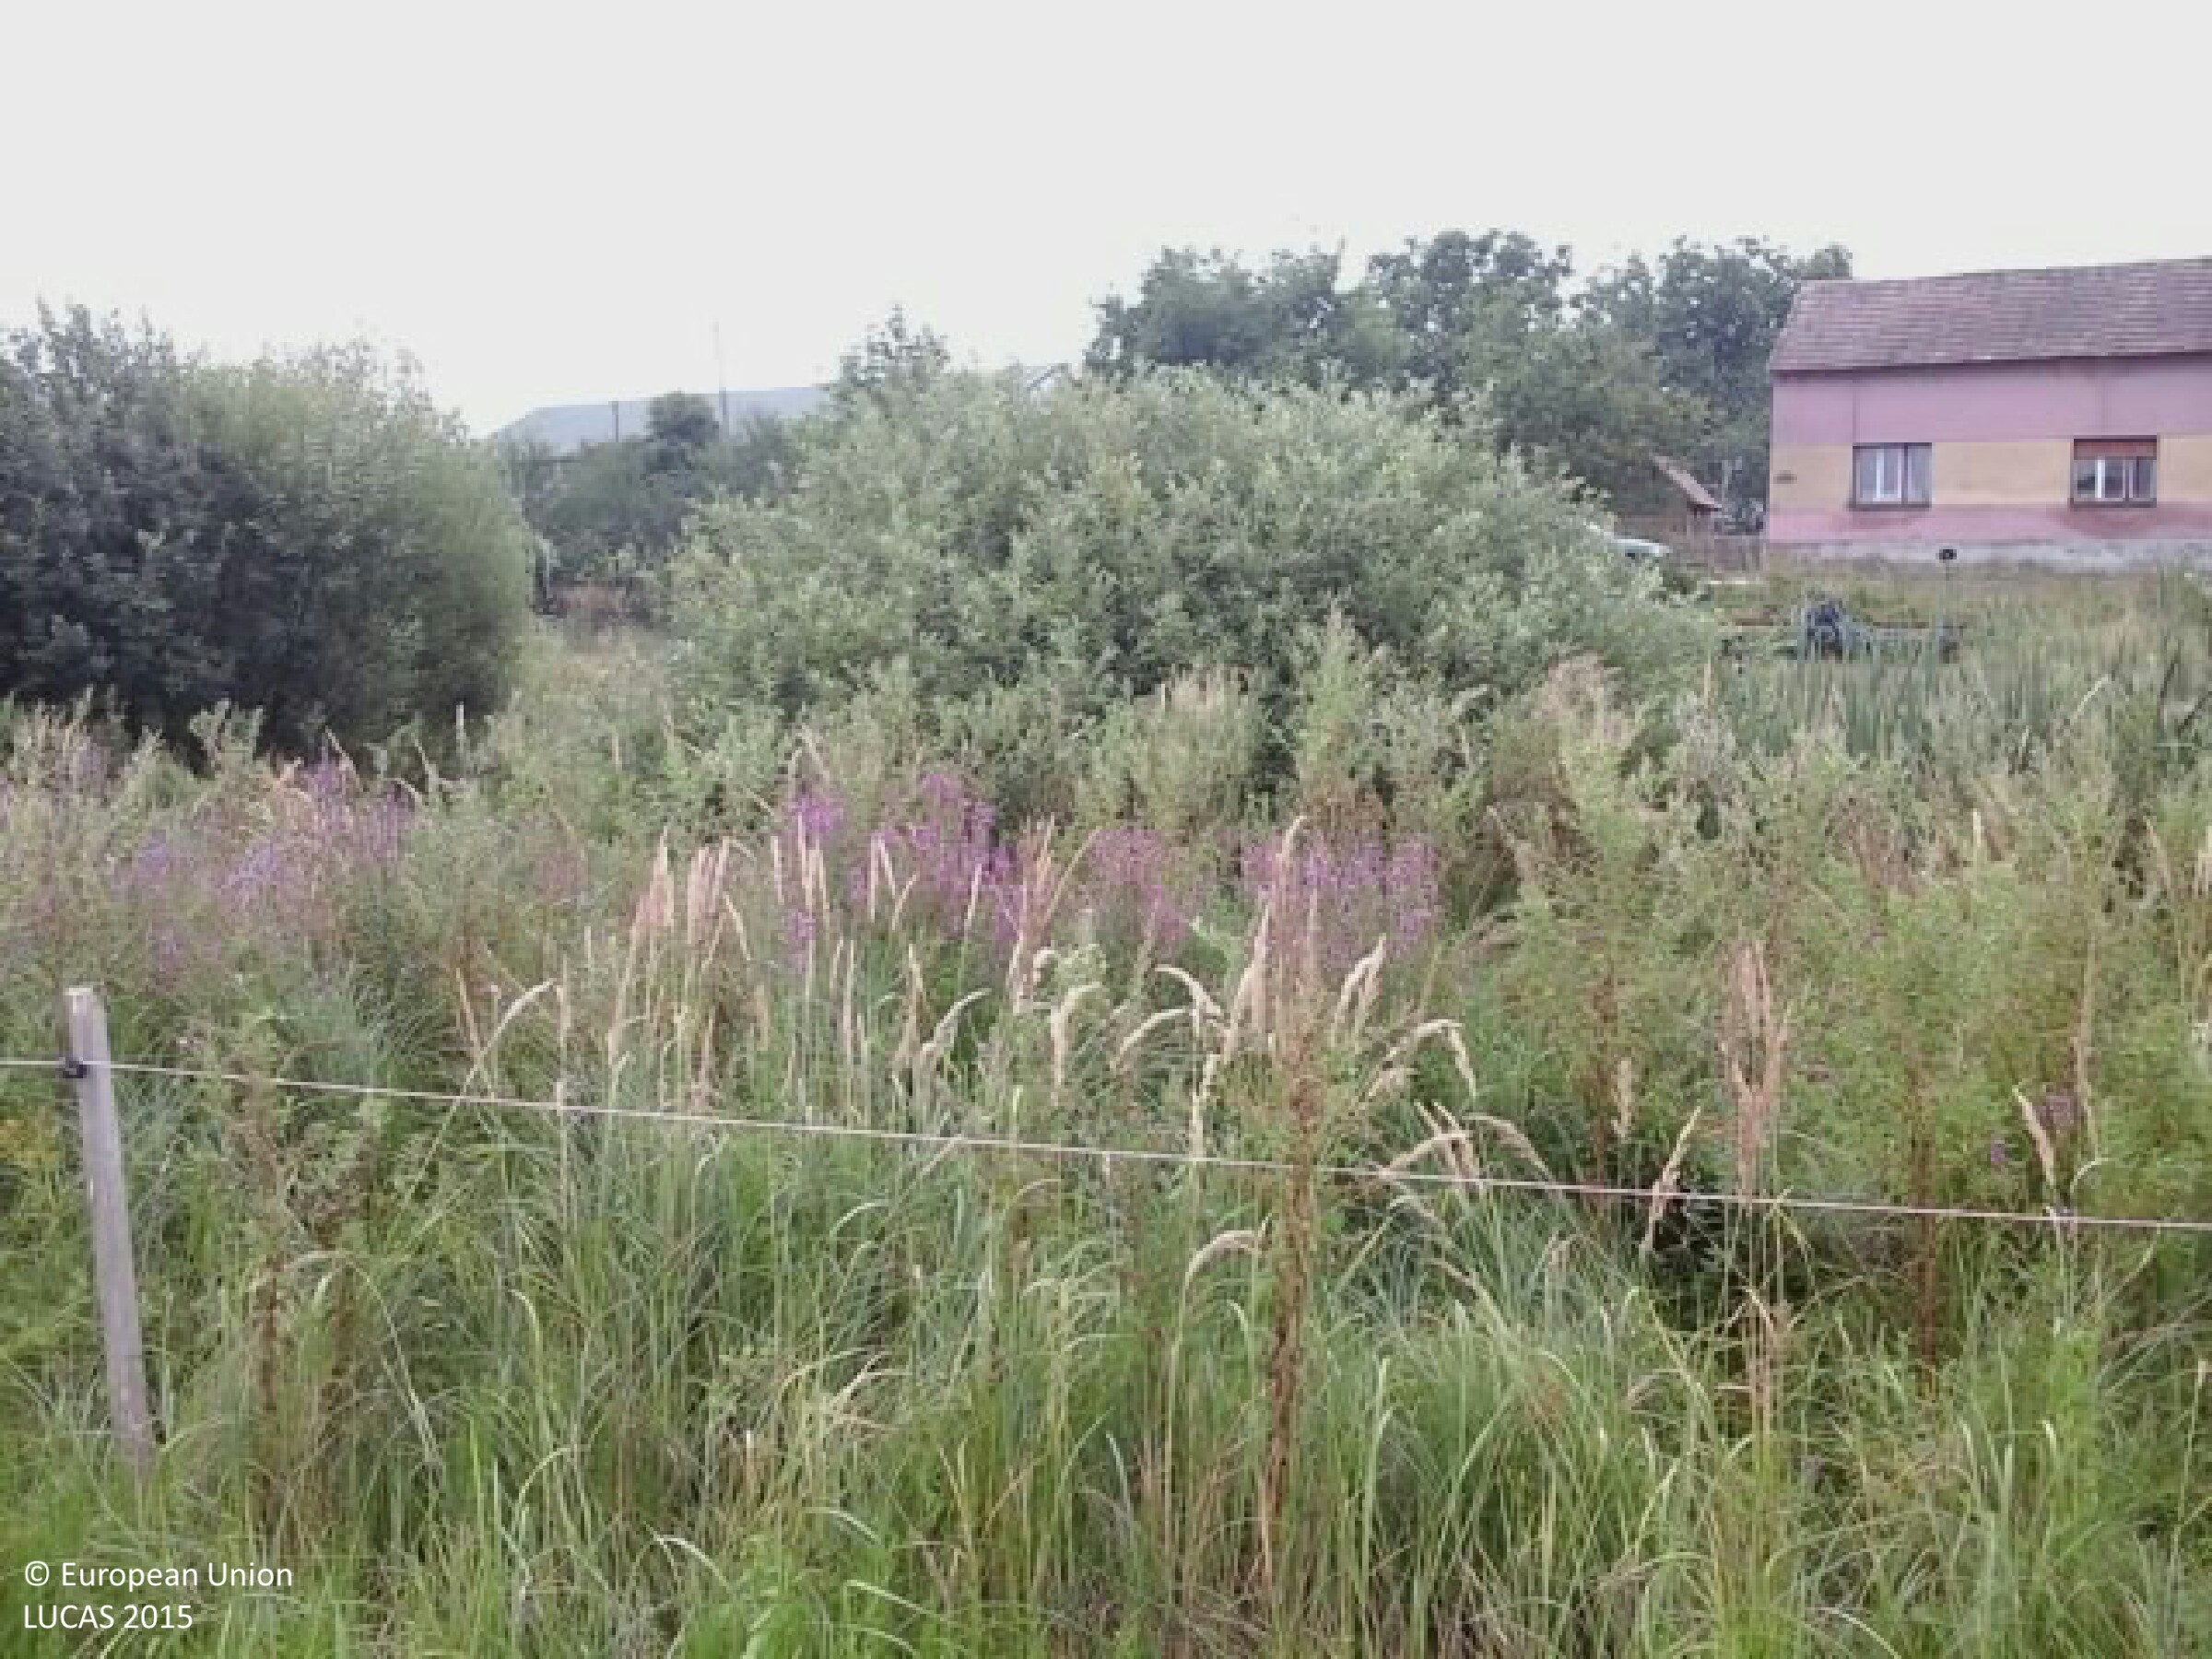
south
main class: Grassland
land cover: Grassland without tree/shrub cover
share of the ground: > 75 %
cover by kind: herbaceous plants 100 %
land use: Agriculture (excluding fallow land and kitchen gardens)
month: July
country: HU
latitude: 46.2138
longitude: 18.0043
